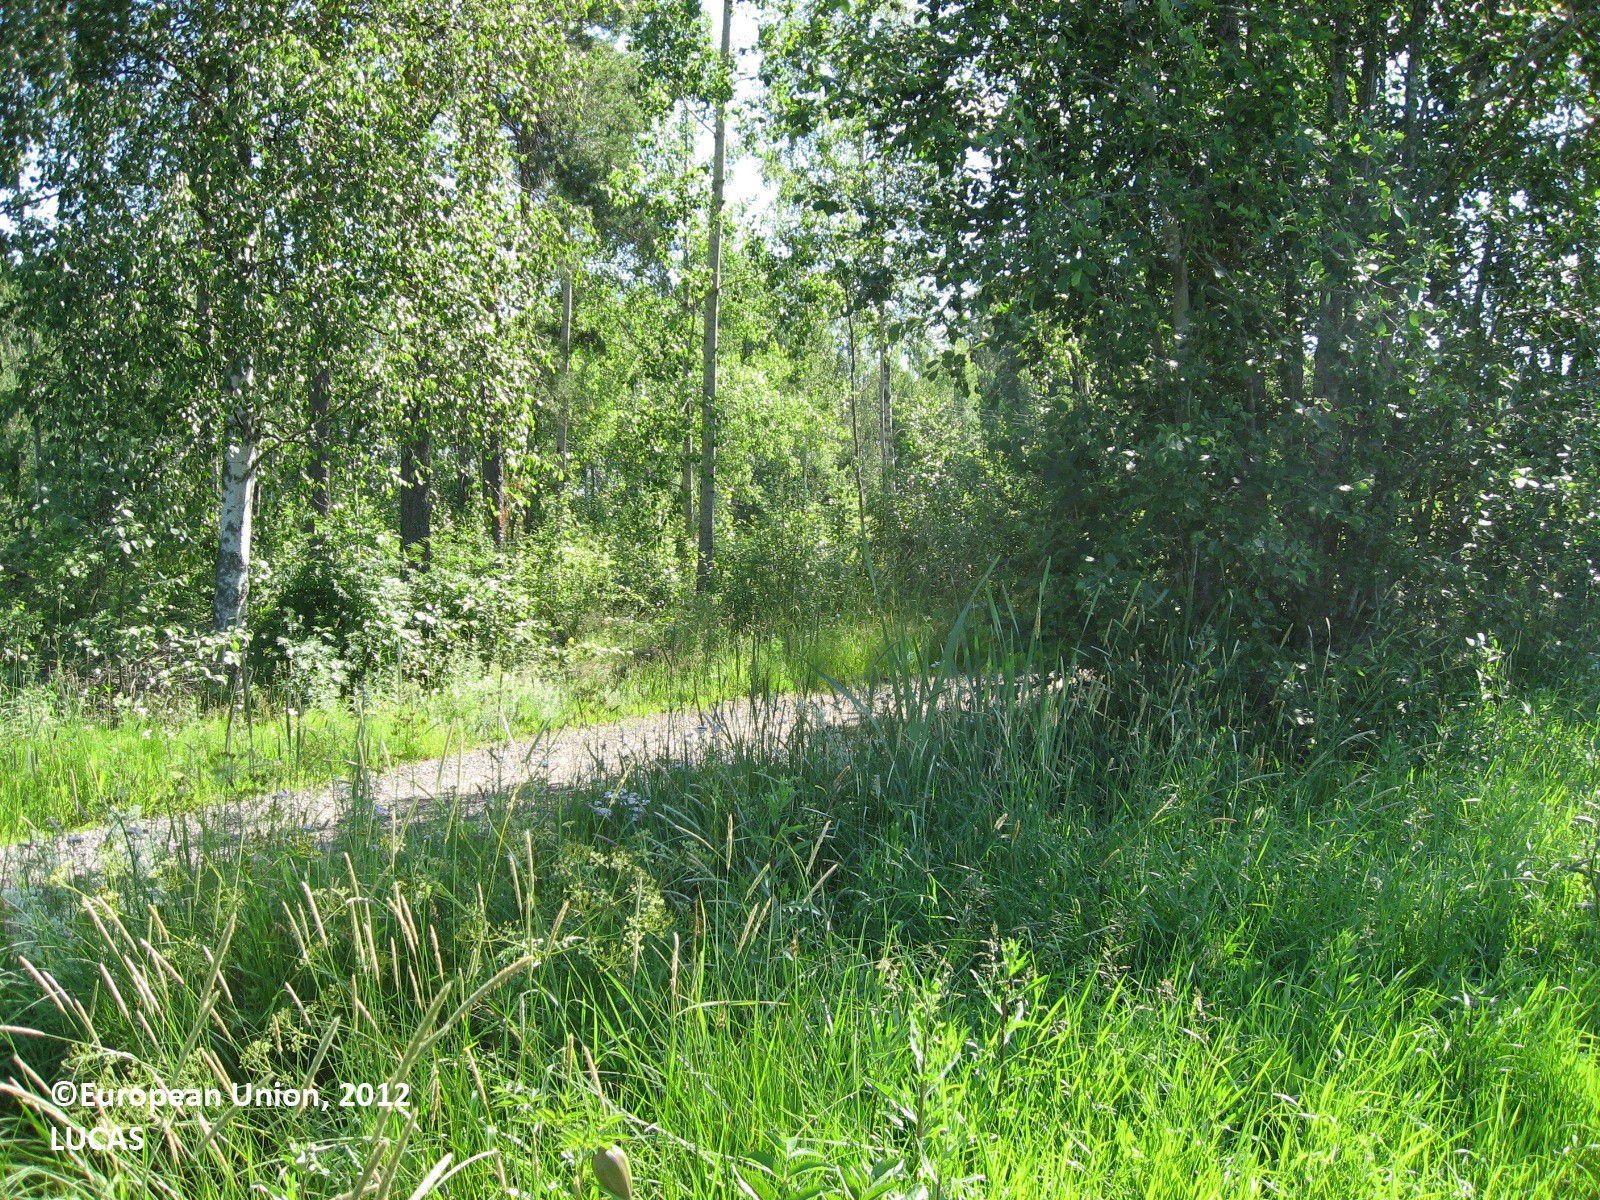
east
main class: Cropland
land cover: Common wheat
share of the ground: 50 - 75 %
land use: Agriculture (excluding fallow land and kitchen gardens)
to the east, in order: Common wheat; Grass margins; Ditches and canals; Broadleaved woodland; Grass margins; Paved roads, cycling and walking lanes; Grass margins; Ditches and canals; Pine dominated mixed woodland; Ditches and canals; Rape and turnip rape; Electric lines; Ditches and canals; Grass margins; Broadleaved woodland; Rock outcrops; Spontaneously vegetated surfaces; Artificial constructions in urban areas; Paved roads, cycling and walking lanes; Spontaneously vegetated surfaces; Managed hedges; Spruce dominated mixed woodland; Ditches and canals; Grass margins; Paved roads, cycling and walking lanes; Spruce dominated coniferous woodland; Artificial constructions in urban areas; Grassland with sparse tree/shrub cover
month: July
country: FI
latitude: 60.9665
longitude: 26.5374
